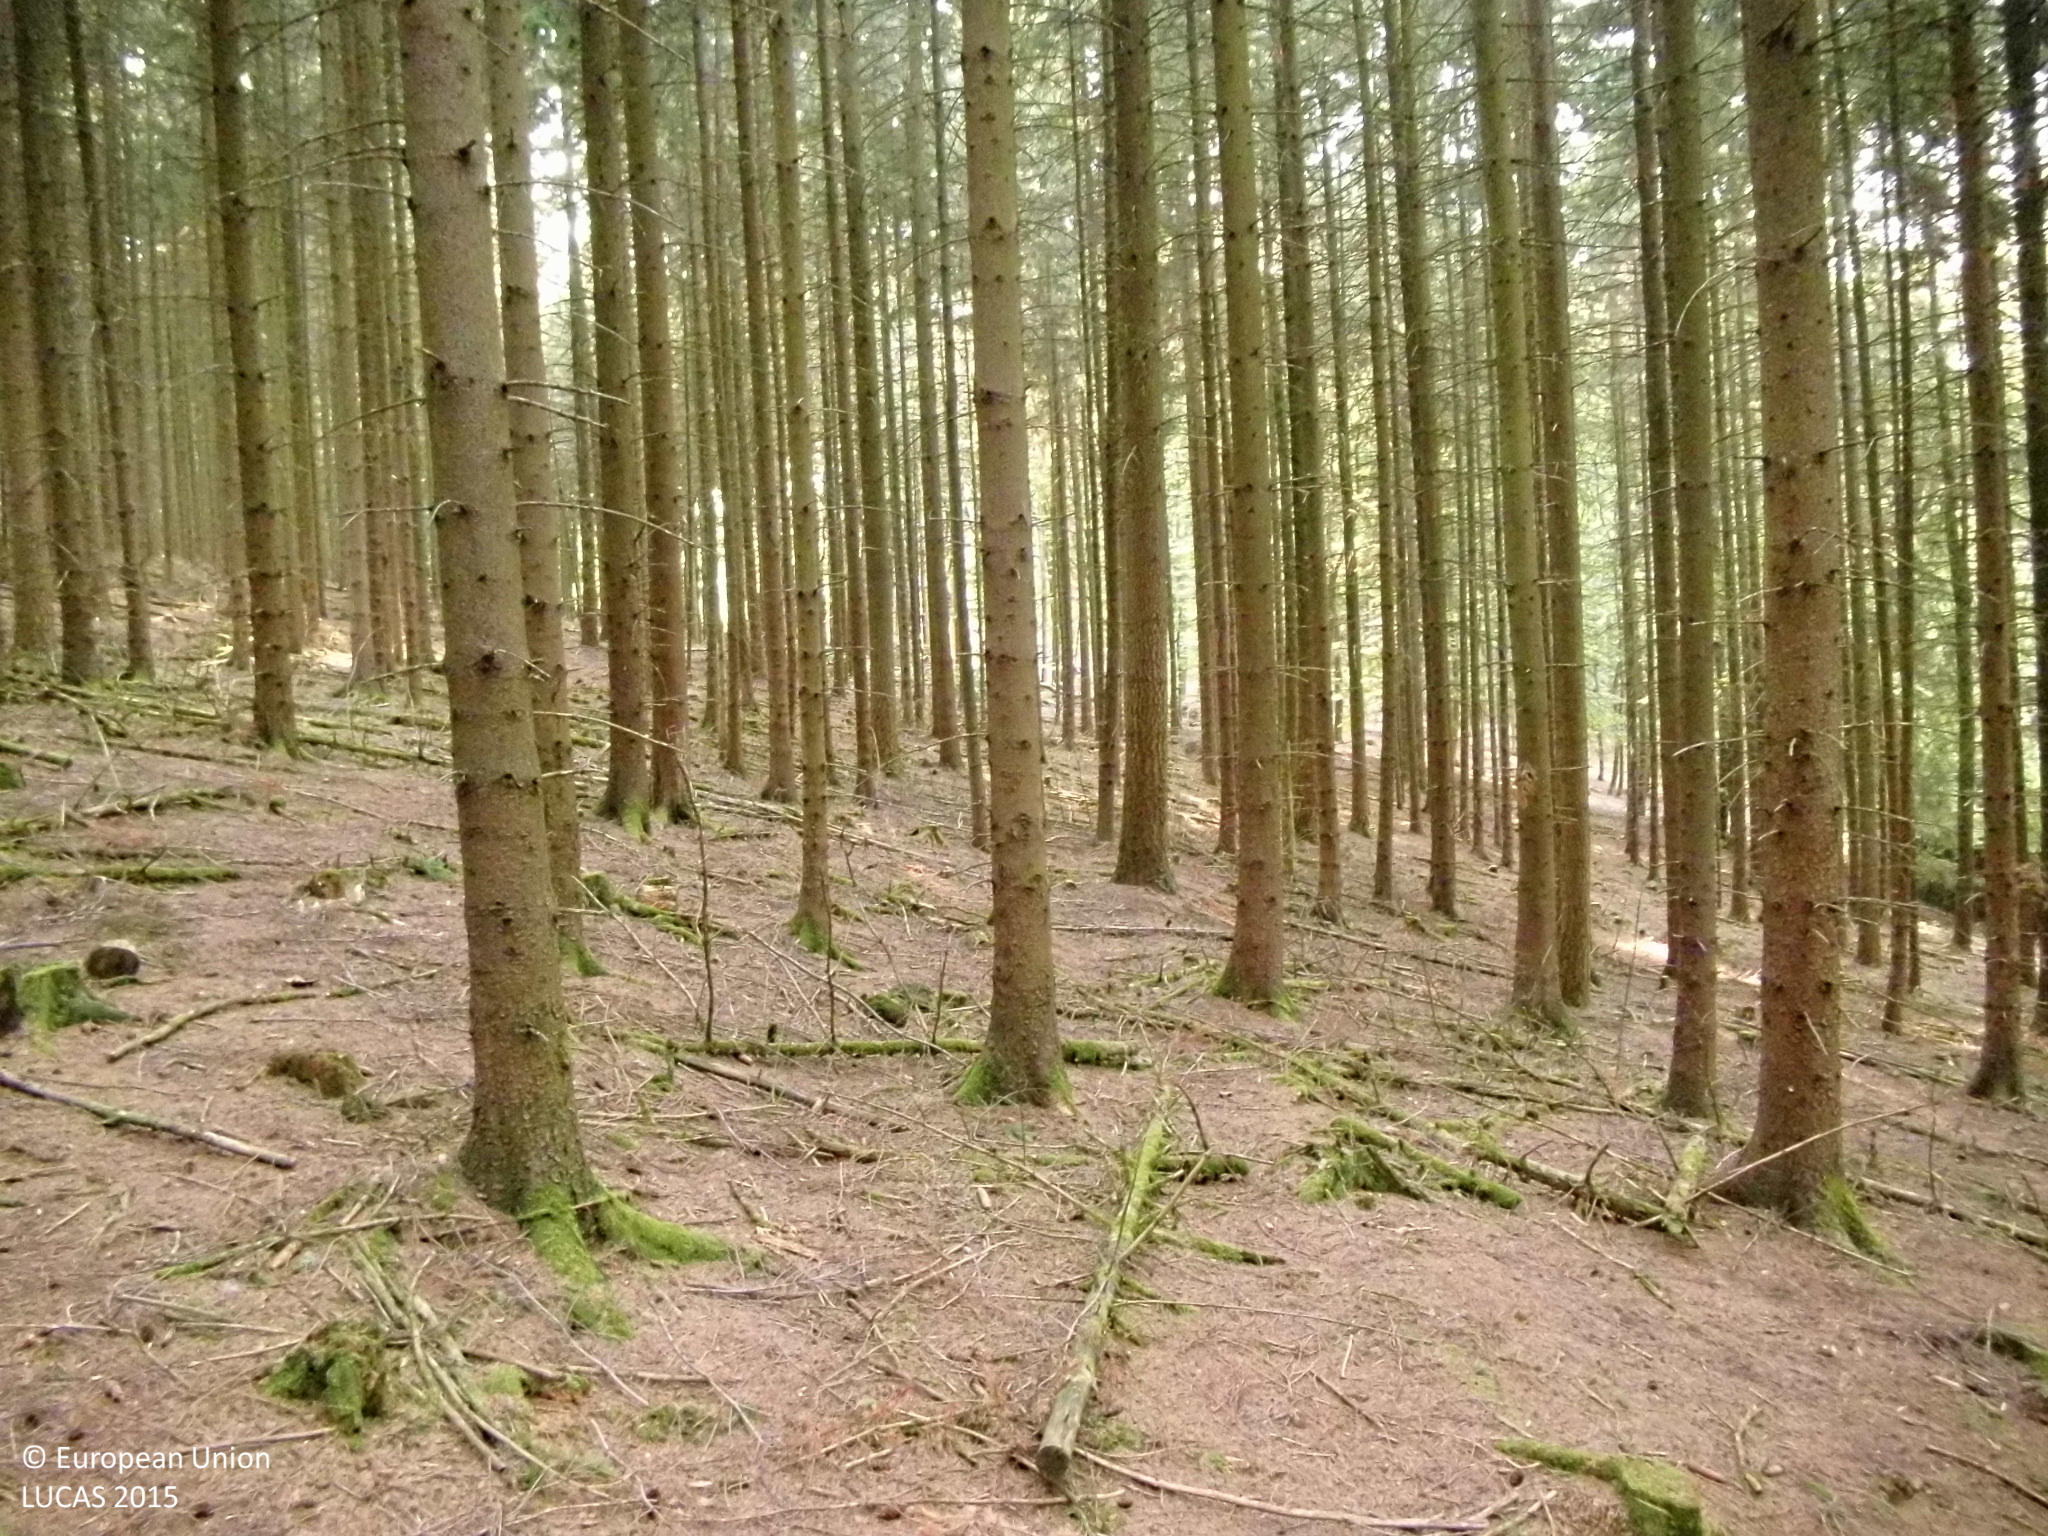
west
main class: Woodland
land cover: Other coniferous woodland
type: hemiboreal forest and nemoral coniferous forest and mixed broadleaved-coniferous forest
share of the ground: > 75 %
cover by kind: coniferous forest trees 90 %, lichens and mosses 5 %, unconsolidated bare surface 5 %
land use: Forestry
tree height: > 5 m
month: August
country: DE
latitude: 50.8230
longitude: 8.5950
